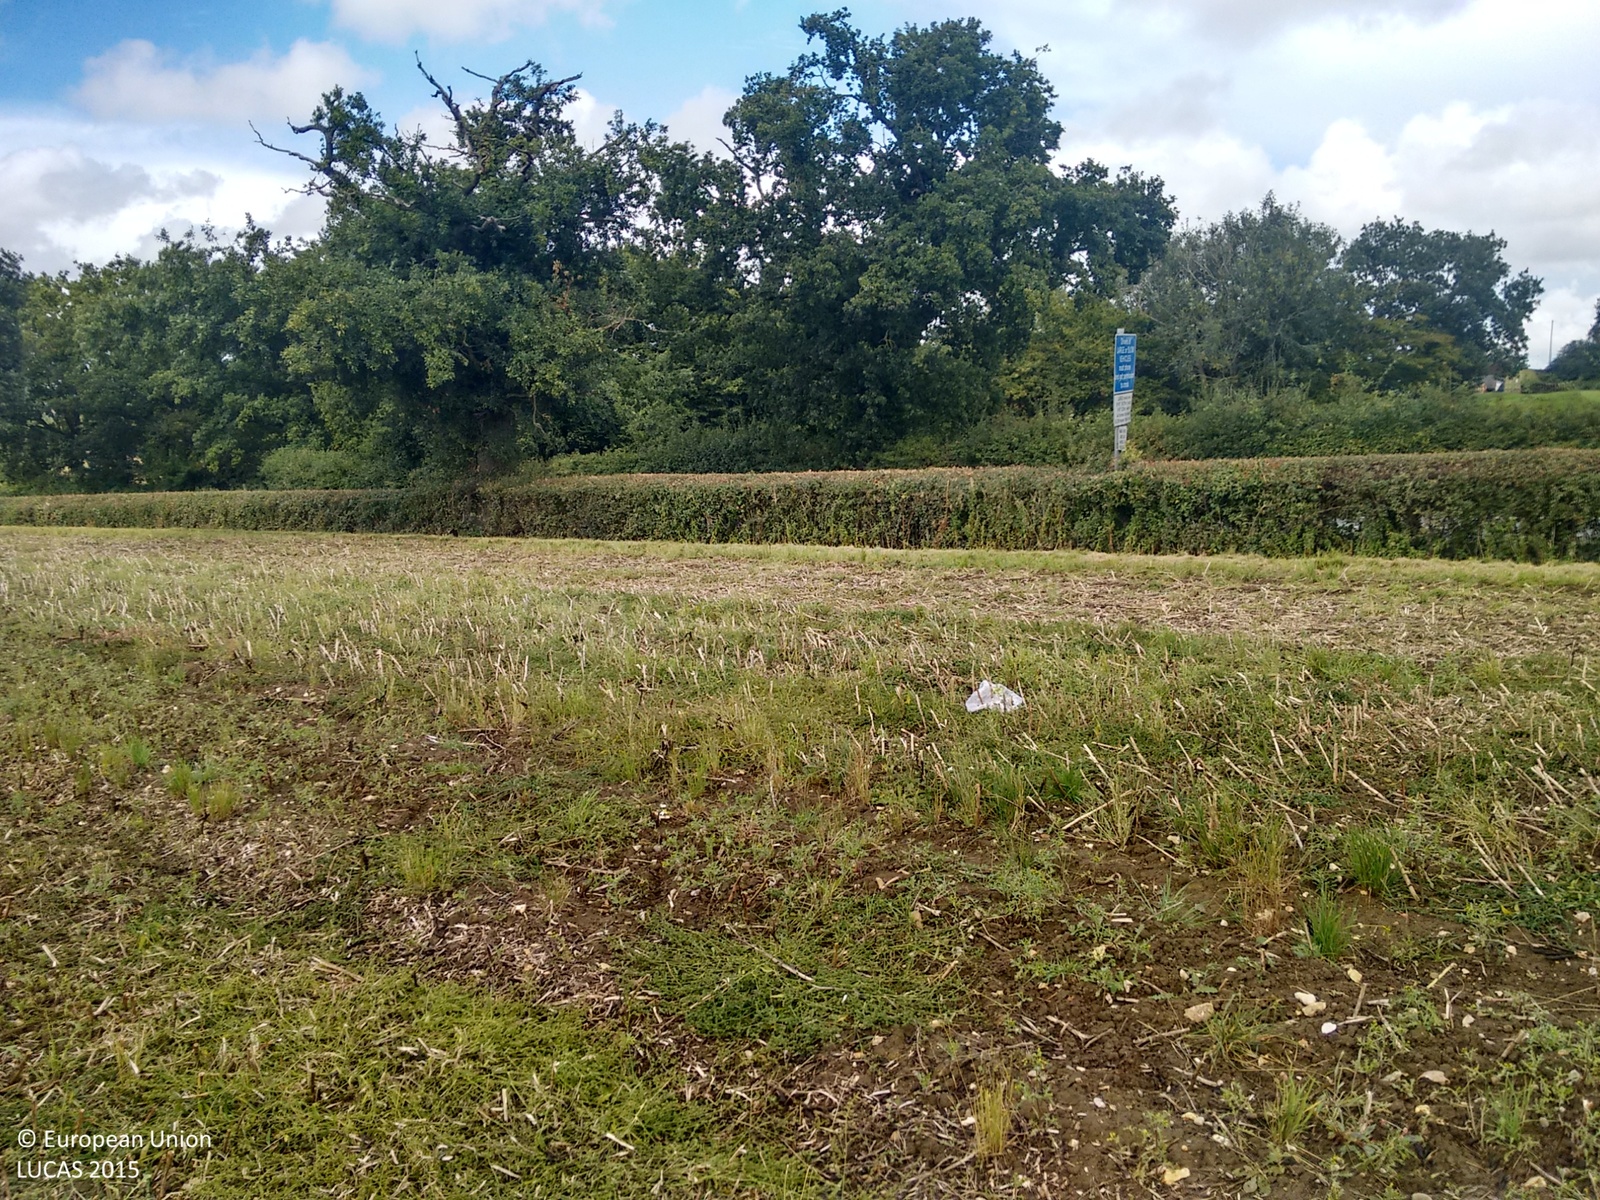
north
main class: Cropland
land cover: Dry pulses
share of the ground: 25 - 50 %
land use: Agriculture (excluding fallow land and kitchen gardens)
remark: Harvested field
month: September
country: GB
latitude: 52.3264
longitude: 1.5147
